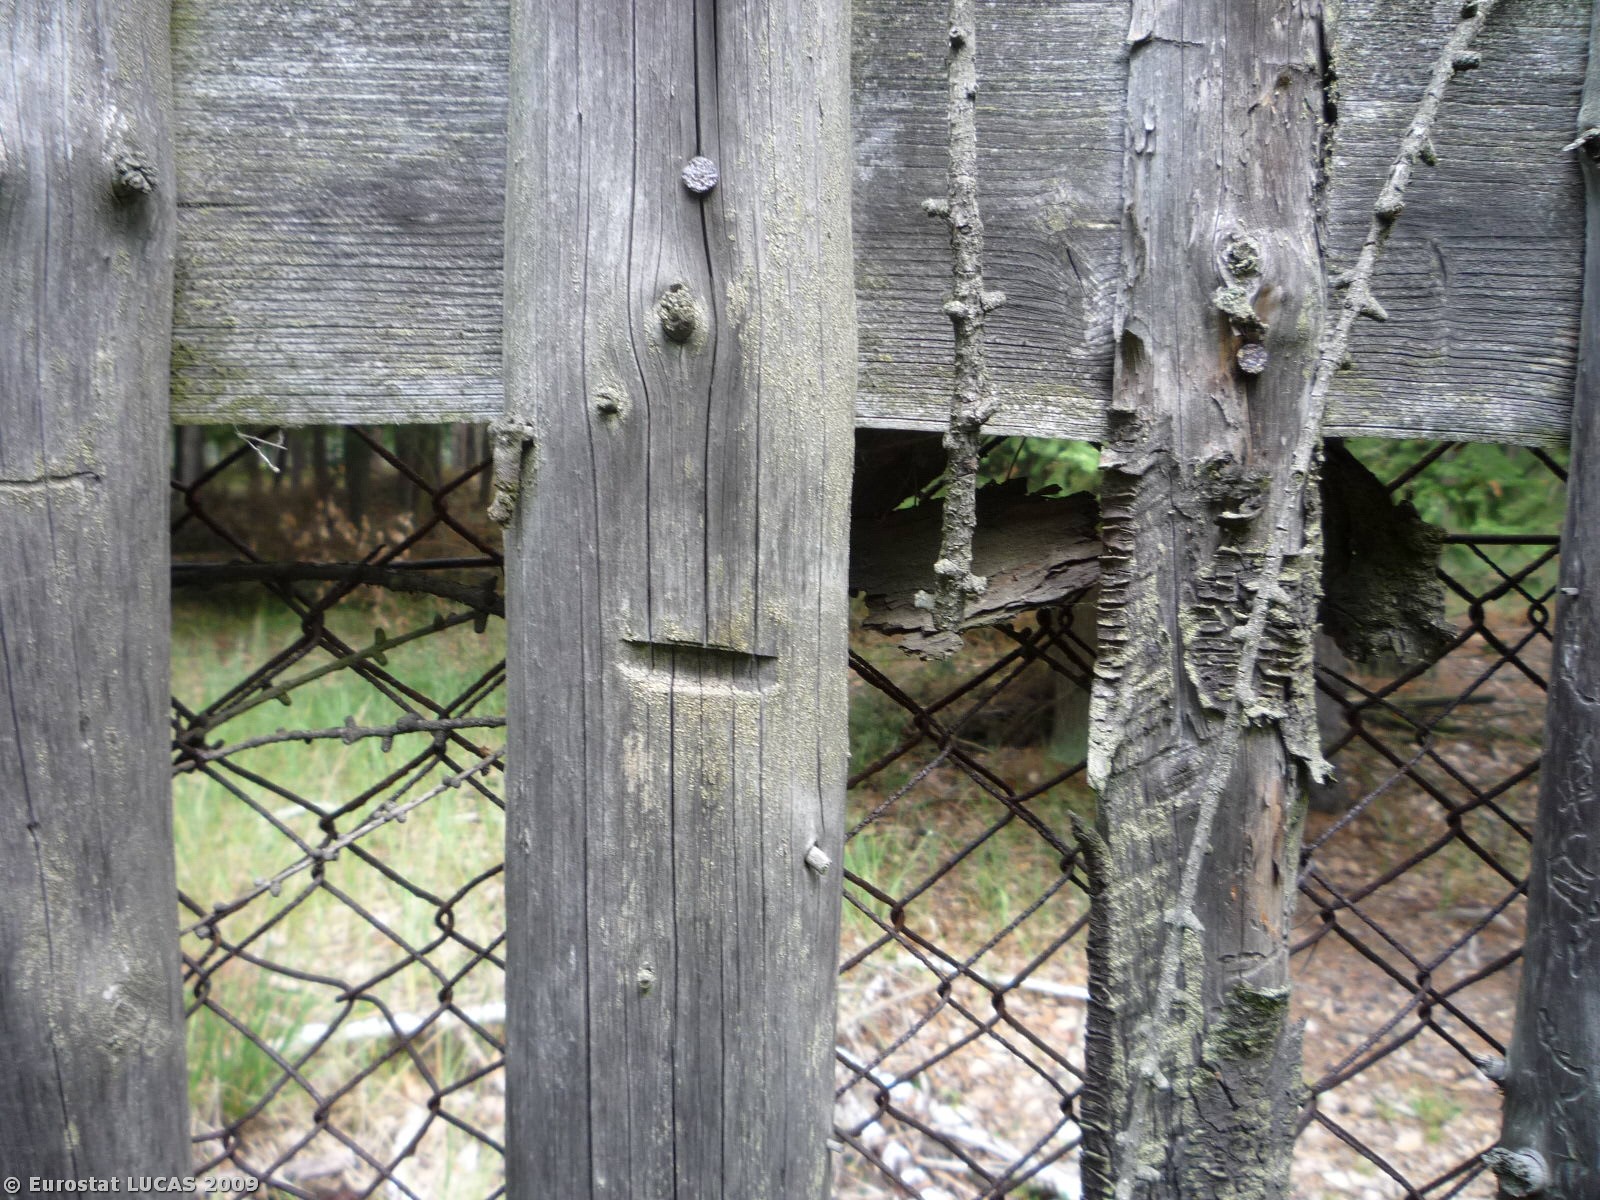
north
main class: Woodland
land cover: Mixed woodland
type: hemiboreal forest and nemoral coniferous forest and mixed broadleaved-coniferous forest
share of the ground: > 75 %
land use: Forestry
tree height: > 5 m
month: June
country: CZ
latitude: 50.3069
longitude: 15.0436
